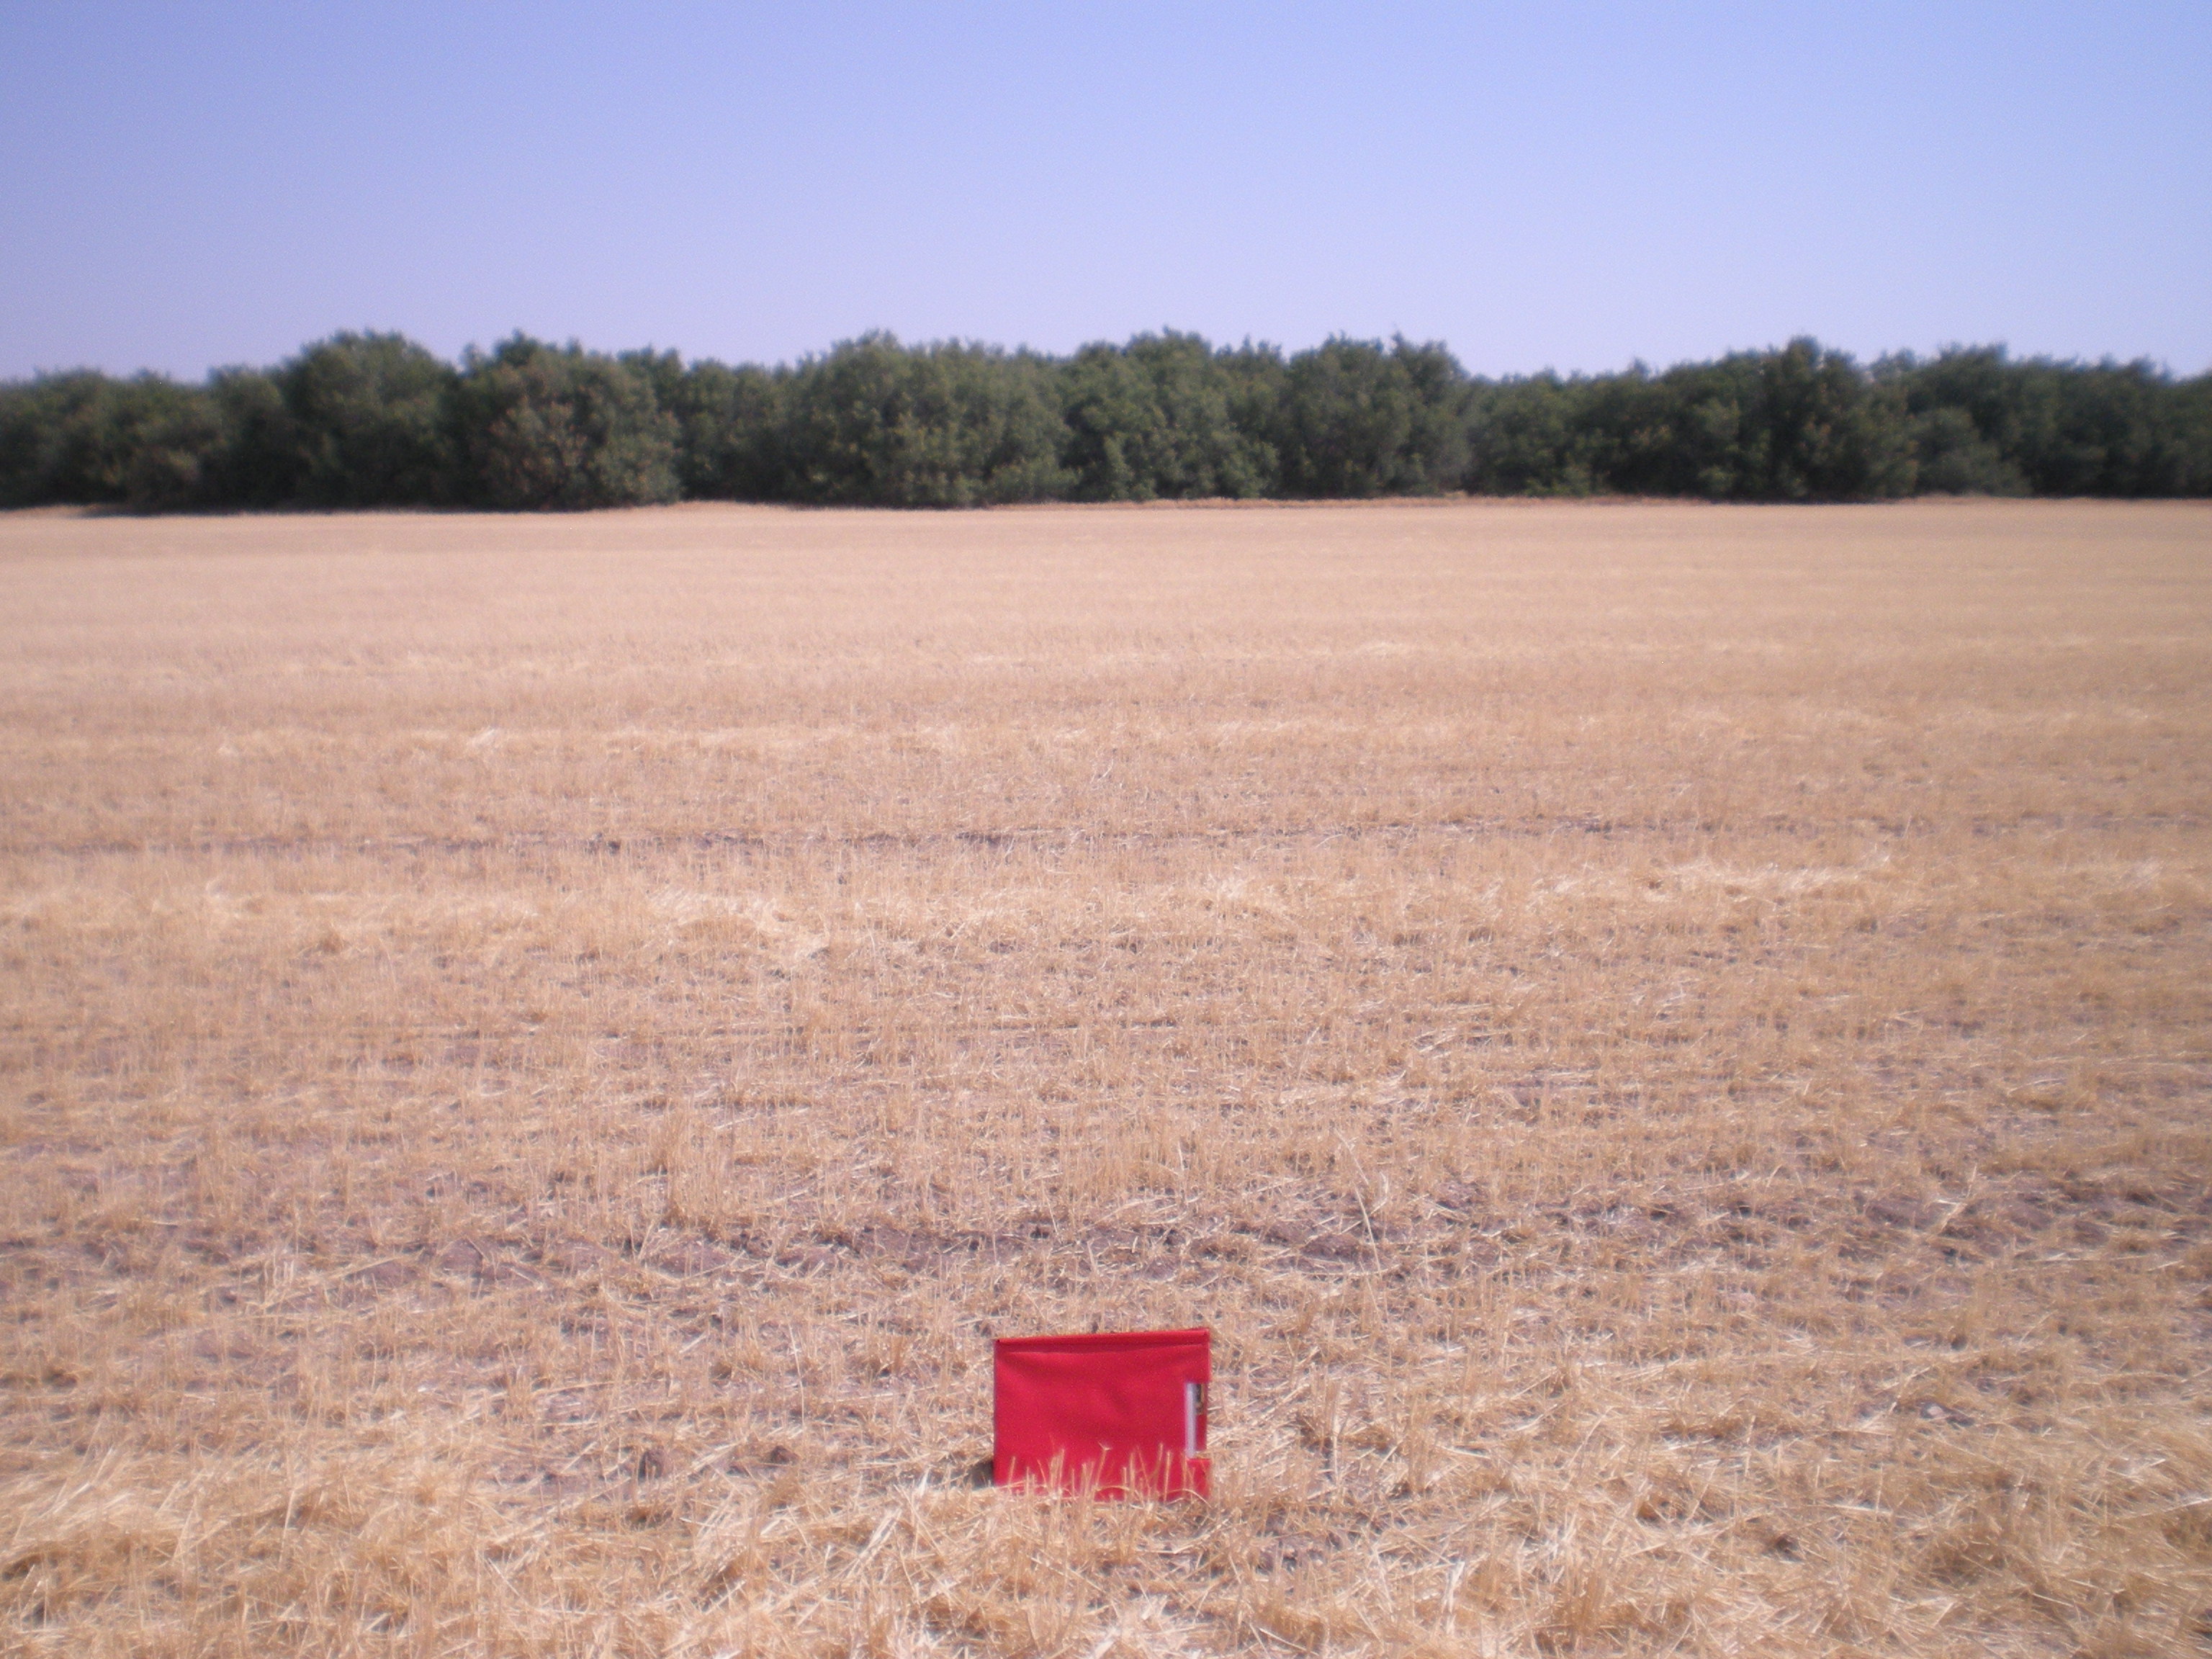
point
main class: Cropland
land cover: Barley
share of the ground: < 10 %
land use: Agriculture (excluding fallow land and kitchen gardens)
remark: Harvested field
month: June
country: ES
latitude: 39.5828
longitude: -3.2588
